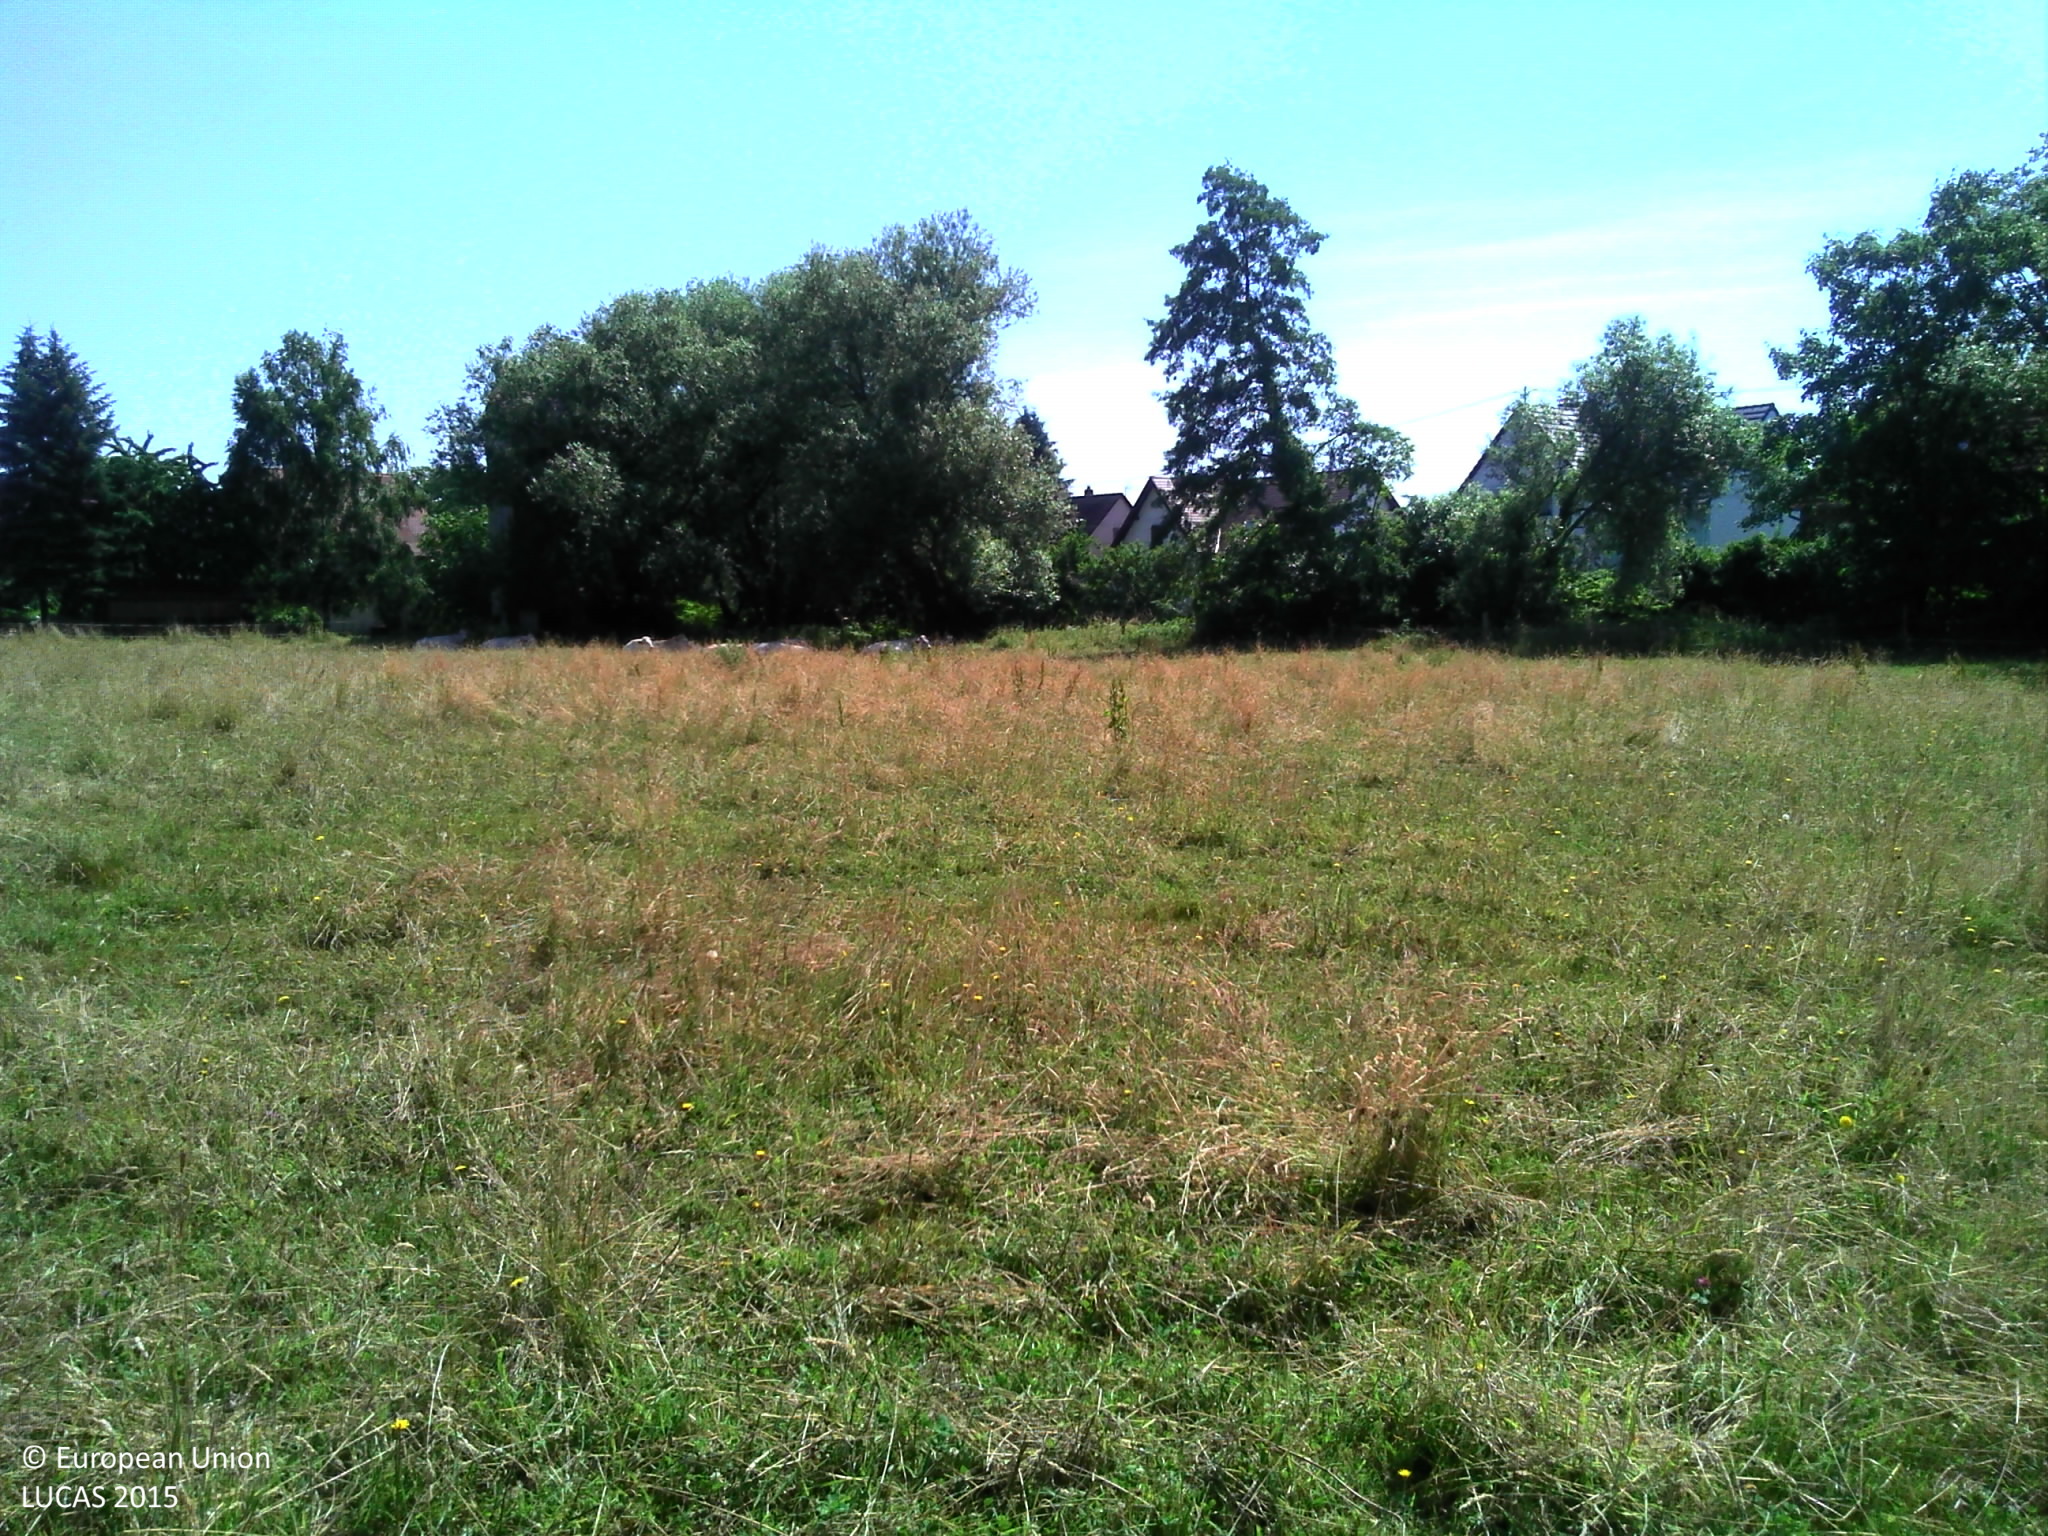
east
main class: Grassland
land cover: Grassland without tree/shrub cover
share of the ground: > 75 %
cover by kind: herbaceous plants 100 %
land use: Agriculture (excluding fallow land and kitchen gardens)
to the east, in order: Grassland without tree/shrub cover; Fences; Grass margins; Abandoned hedges; Inland fresh running water; Abandoned hedges; Artificial constructions in urban areas
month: June
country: FR
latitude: 48.7504
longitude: 7.3757
